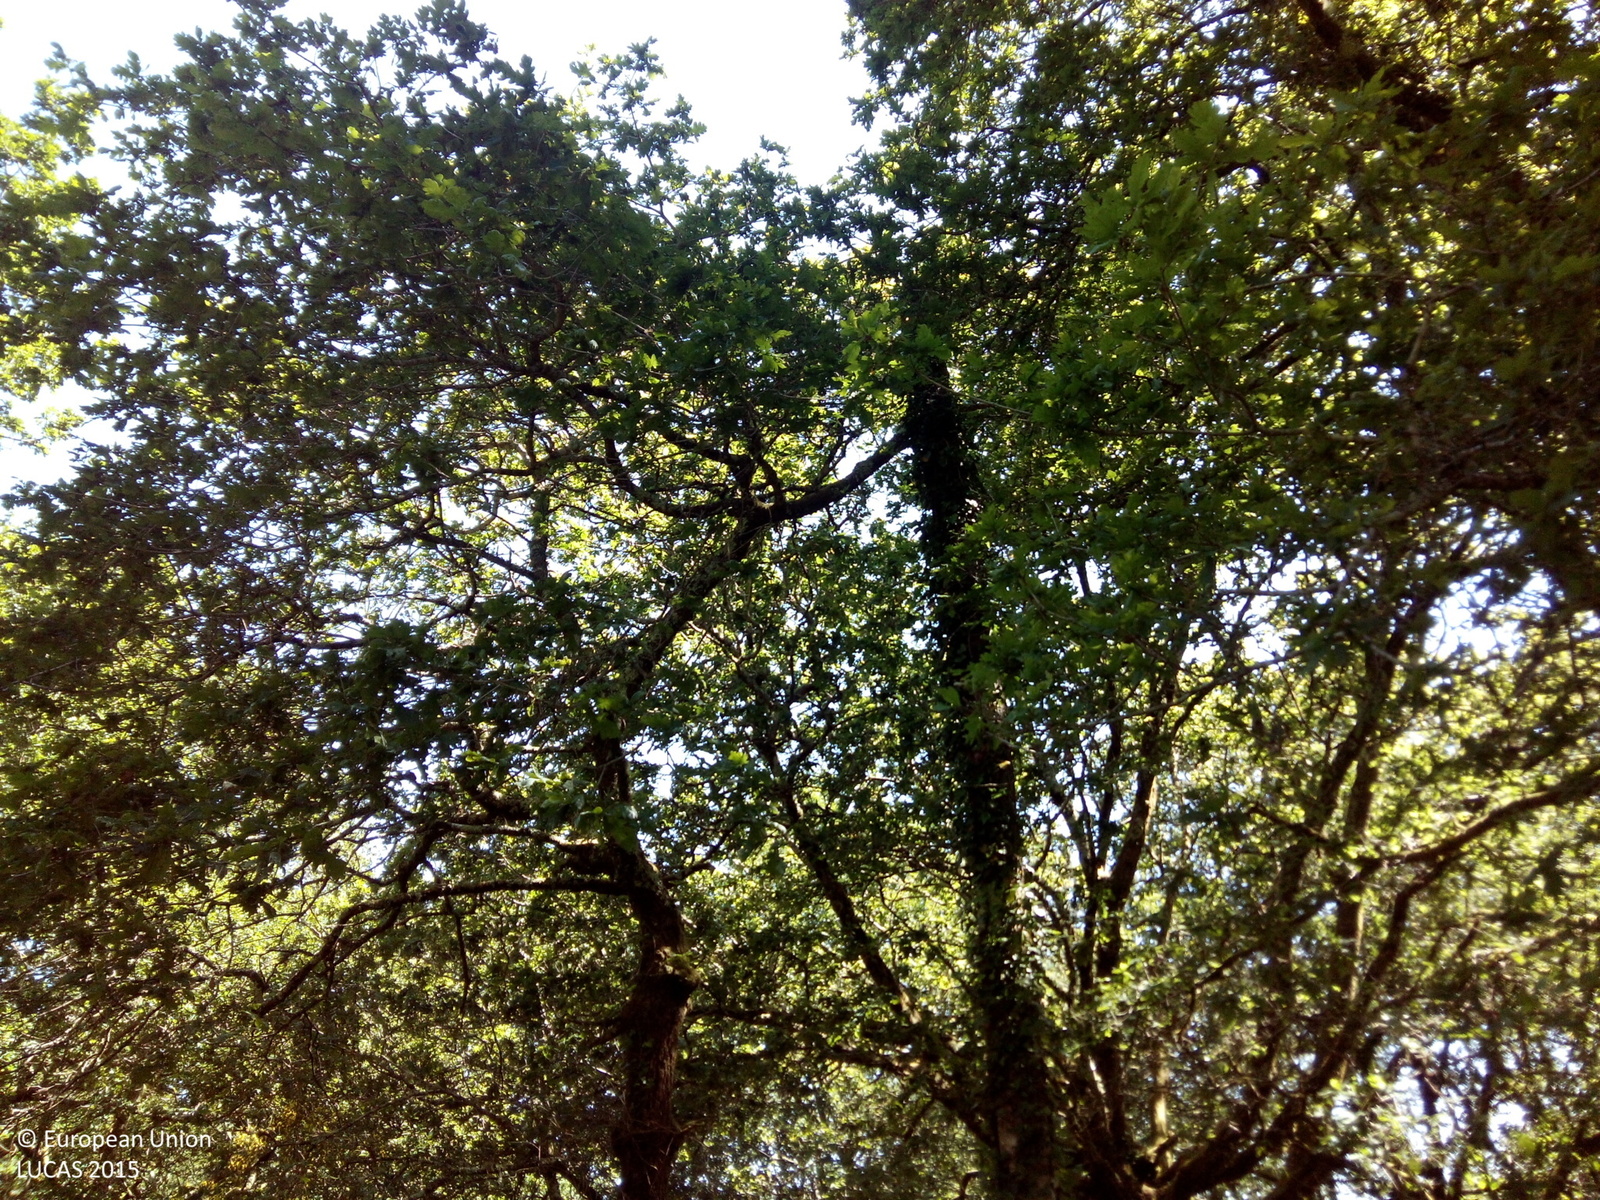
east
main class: Artificial land
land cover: Other artificial areas
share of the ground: < 10 %
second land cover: Shrubland without tree cover
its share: > 75 %
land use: Electricity, gas and thermal power distribution
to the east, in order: Artificial constructions in urban areas; Shrubland without tree cover; Broadleaved woodland; Ditches and canals; Broadleaved woodland; Dry stone walls; Broadleaved woodland; Tracks; Dry stone walls; Broadleaved woodland
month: May
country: ES
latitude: 42.6712
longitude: -8.4884
